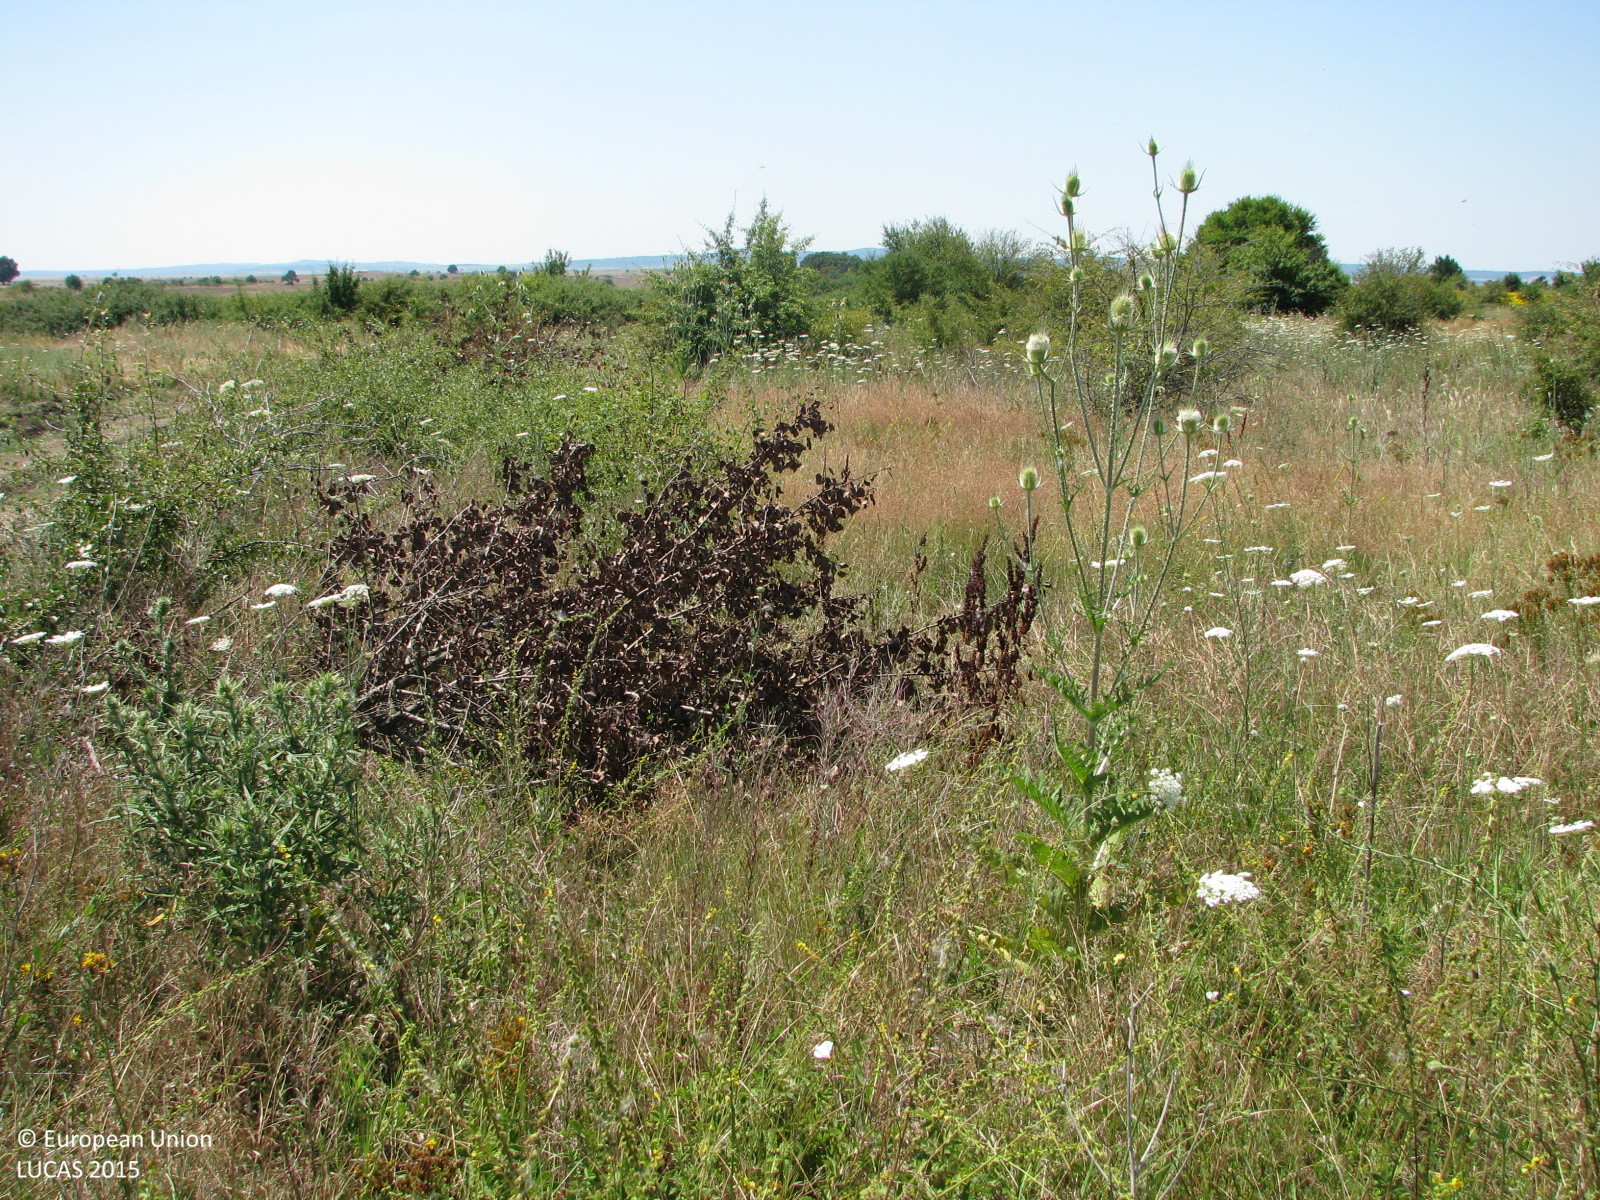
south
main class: Grassland
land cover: Grassland with sparse tree/shrub cover
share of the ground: > 75 %
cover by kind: herbaceous plants 85 %, shrubs 10 %, broadleaved forest trees 5 %
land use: Semi-natural and natural areas not in use
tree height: < 5 m
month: July
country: BG
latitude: 42.2024
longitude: 26.8715
